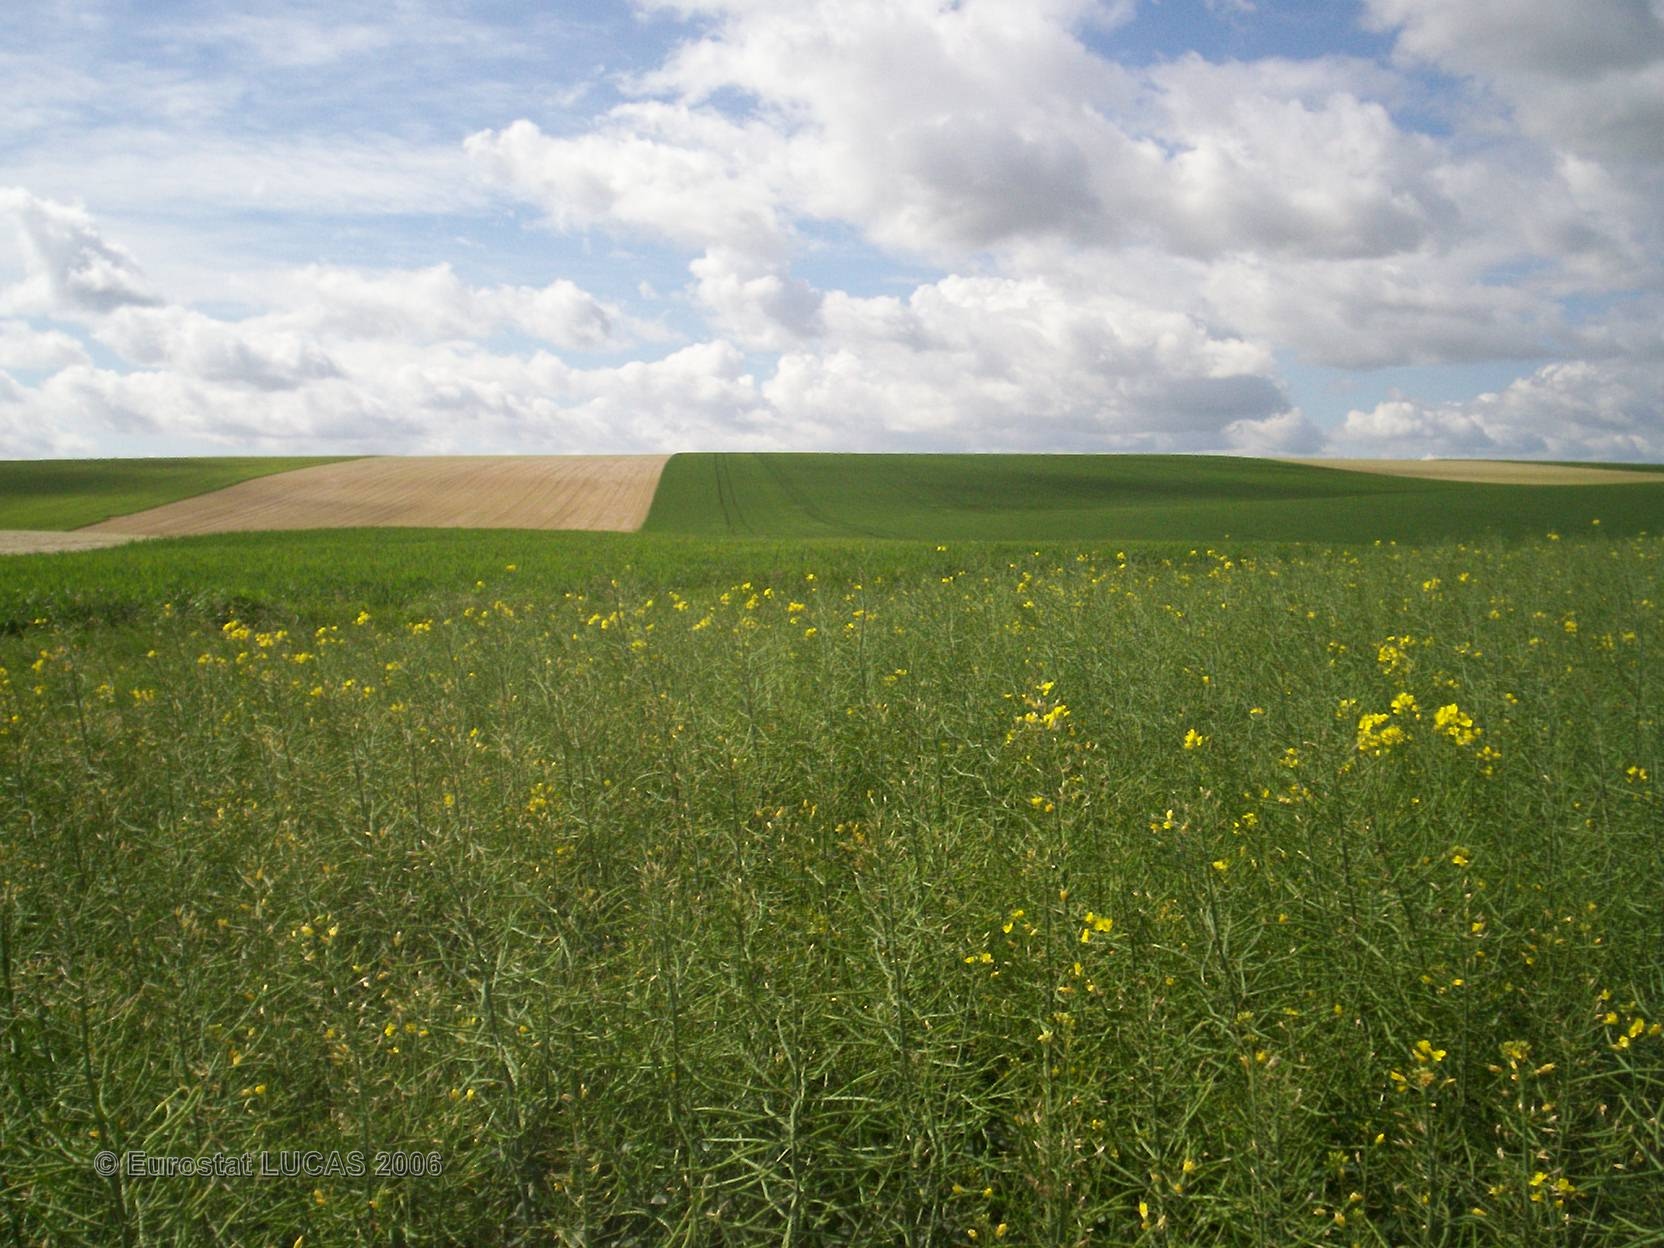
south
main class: Cropland
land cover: Rape and turnip rape
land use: Agriculture (excluding fallow land and kitchen gardens)
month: May
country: FR
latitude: 49.4715
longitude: 4.4347
